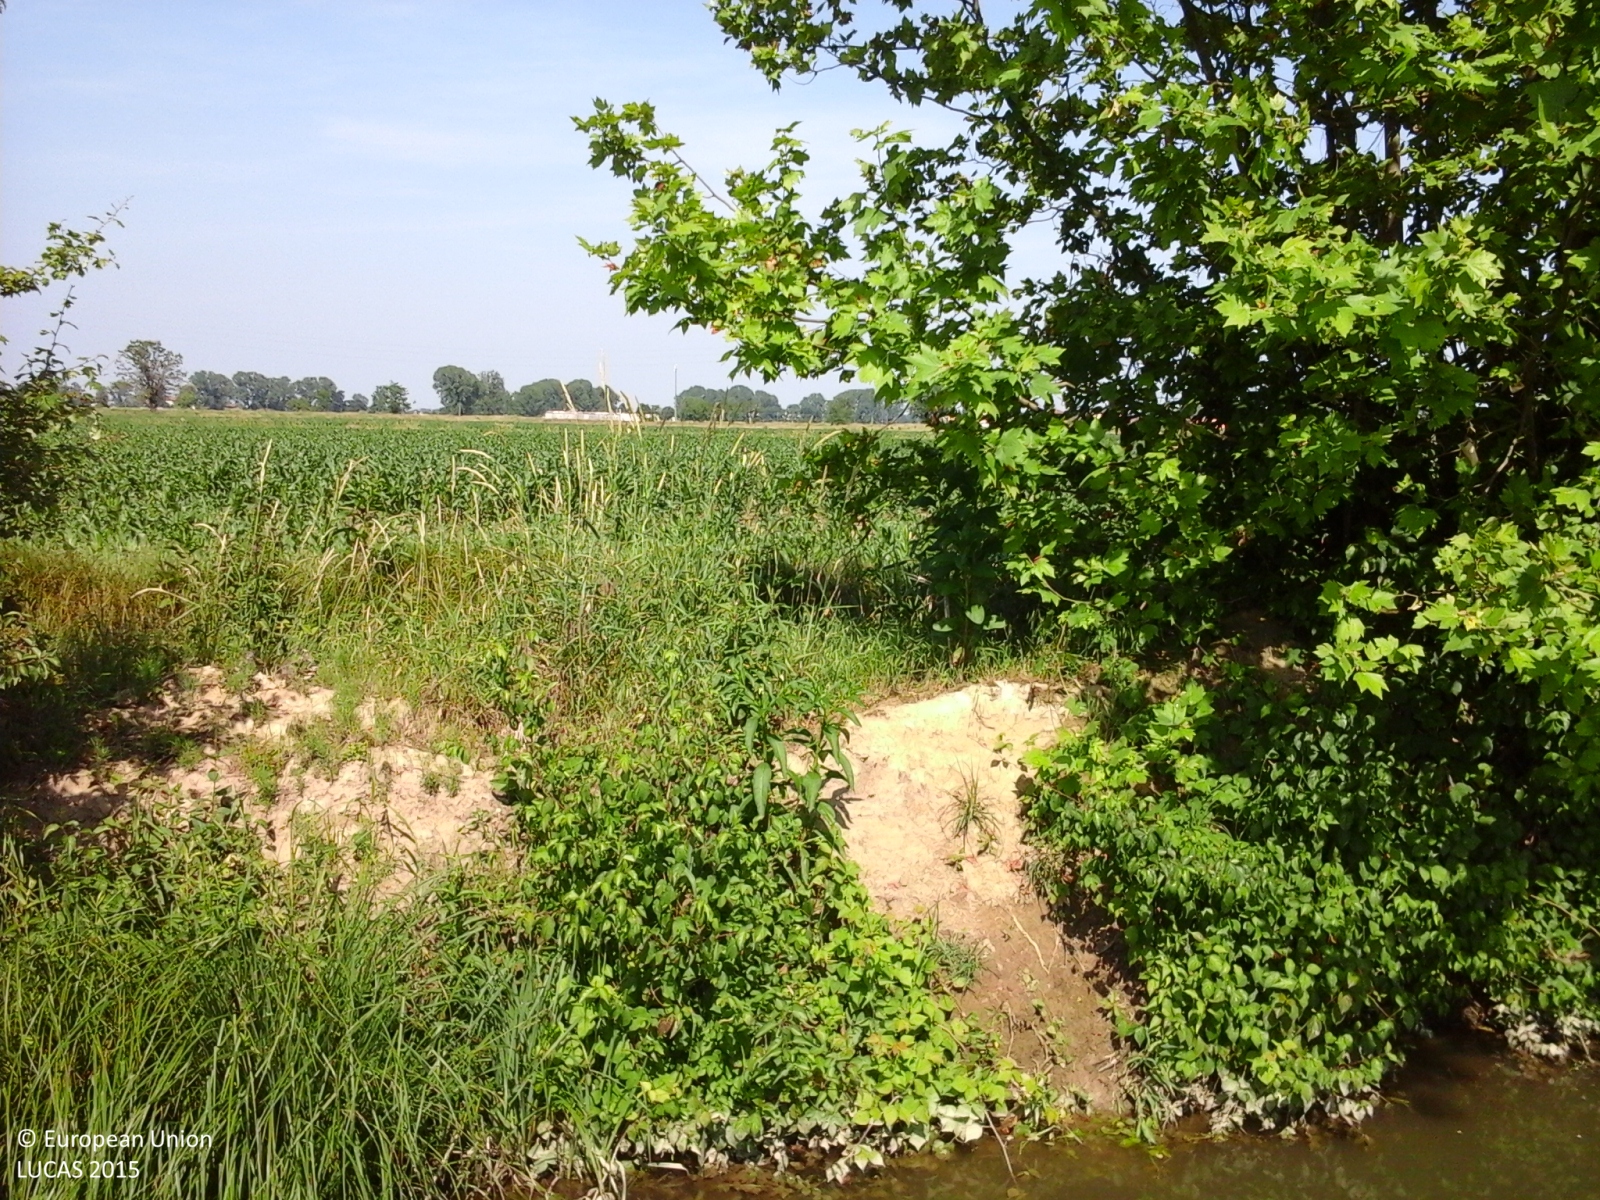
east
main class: Cropland
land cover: Maize
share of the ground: > 75 %
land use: Agriculture (excluding fallow land and kitchen gardens)
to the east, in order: Maize; Grass margins; Ditches and canals; Grassland without tree/shrub cover; Maize
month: May
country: IT
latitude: 45.2151
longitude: 9.5552
